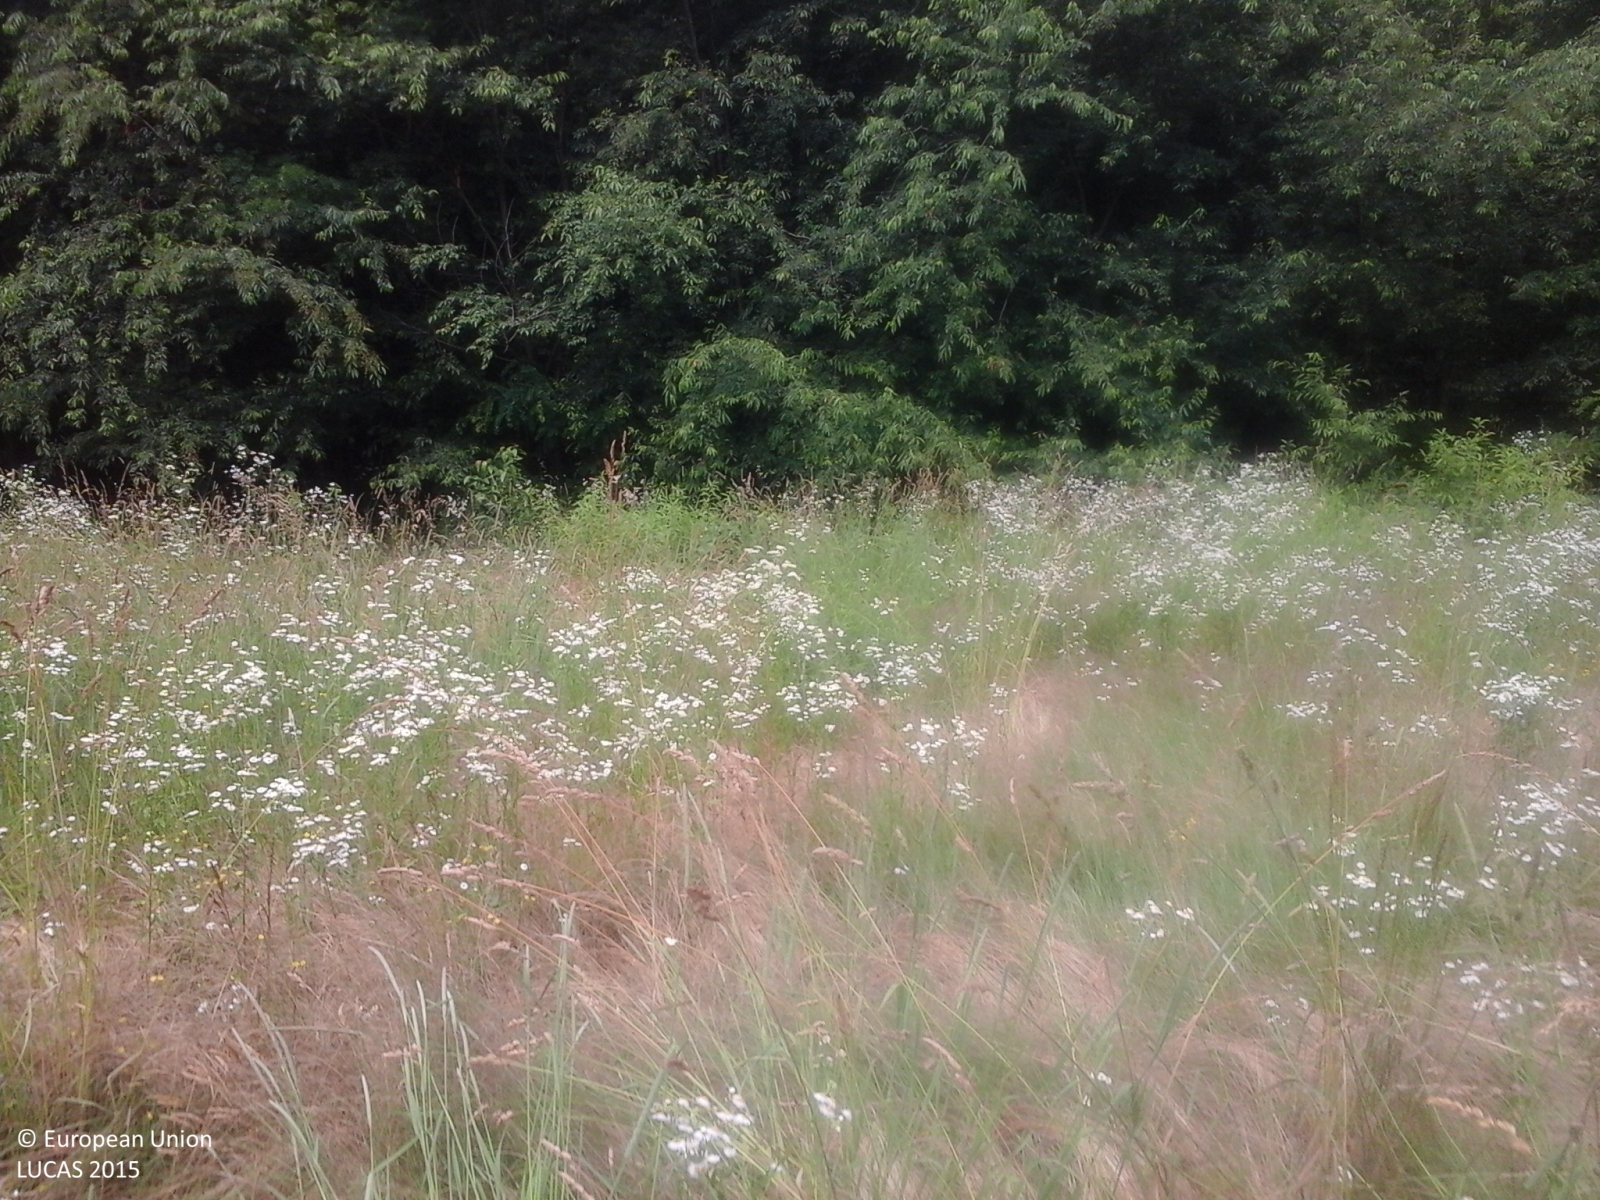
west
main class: Grassland
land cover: Spontaneously vegetated surfaces
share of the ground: > 75 %
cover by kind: herbaceous plants 100 %
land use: Fallow land
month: June
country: IT
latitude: 45.5698
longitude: 8.8103
